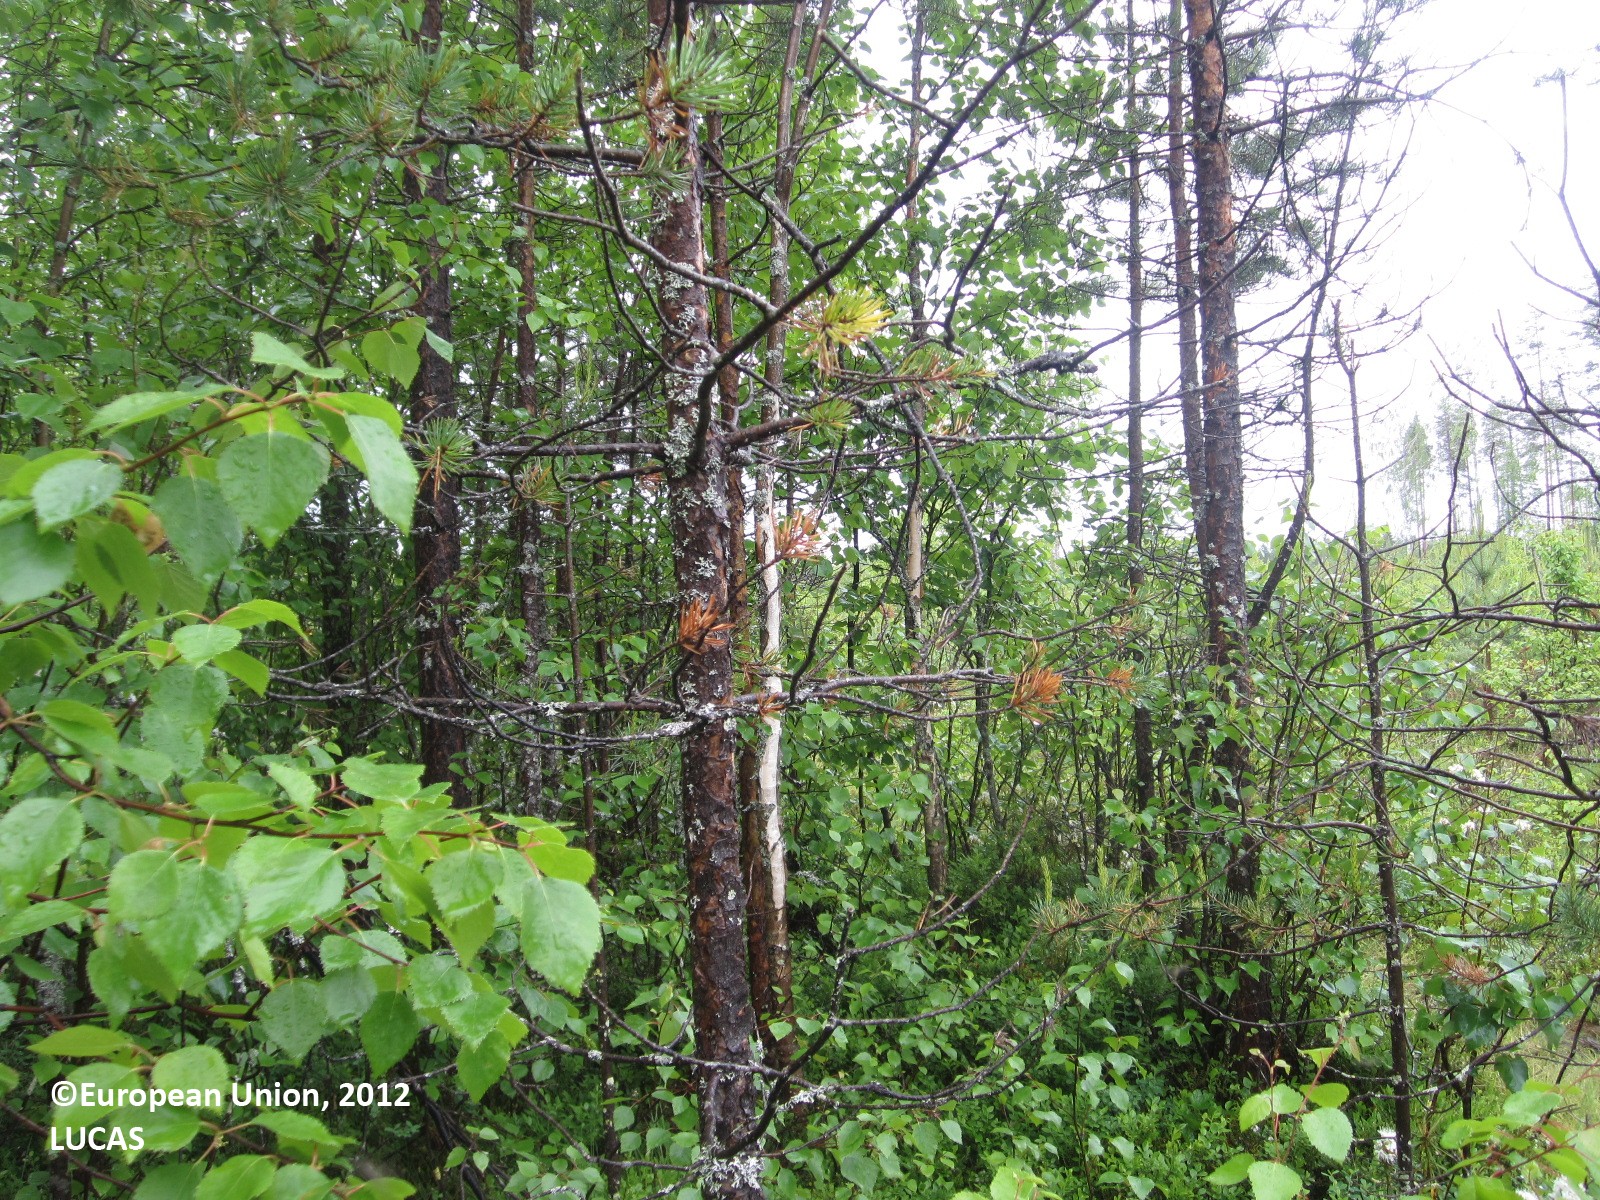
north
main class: Woodland
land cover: Pine dominated mixed woodland
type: boreal forest
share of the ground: 50 - 75 %
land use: Forestry
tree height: > 5 m
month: June
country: FI
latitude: 64.3298
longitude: 29.6497
